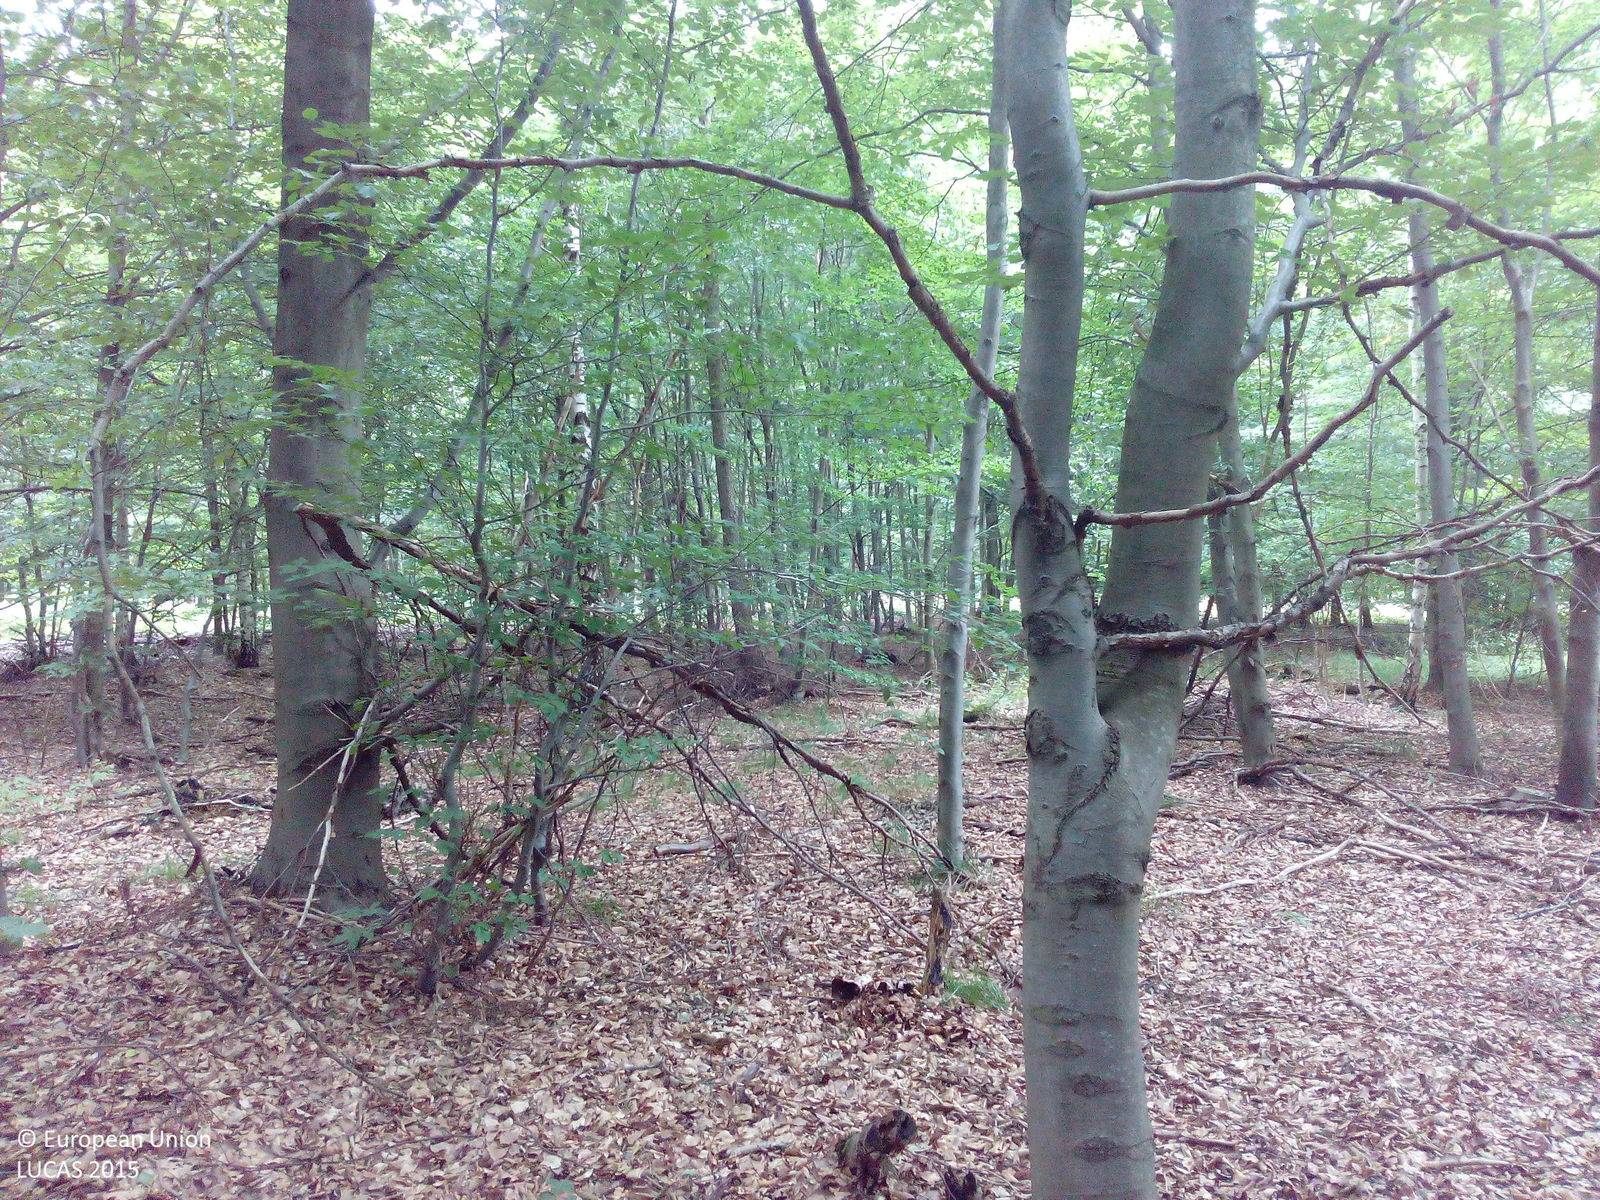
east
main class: Woodland
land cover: Broadleaved woodland
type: beech forest
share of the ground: > 75 %
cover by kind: broadleaved forest trees 100 %
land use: Forestry
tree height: > 5 m
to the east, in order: Broadleaved woodland; Spruce dominated mixed woodland; Spontaneously vegetated surfaces; Spruce dominated mixed woodland; Spruce dominated coniferous woodland
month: August
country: DE
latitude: 51.6891
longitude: 11.1135
